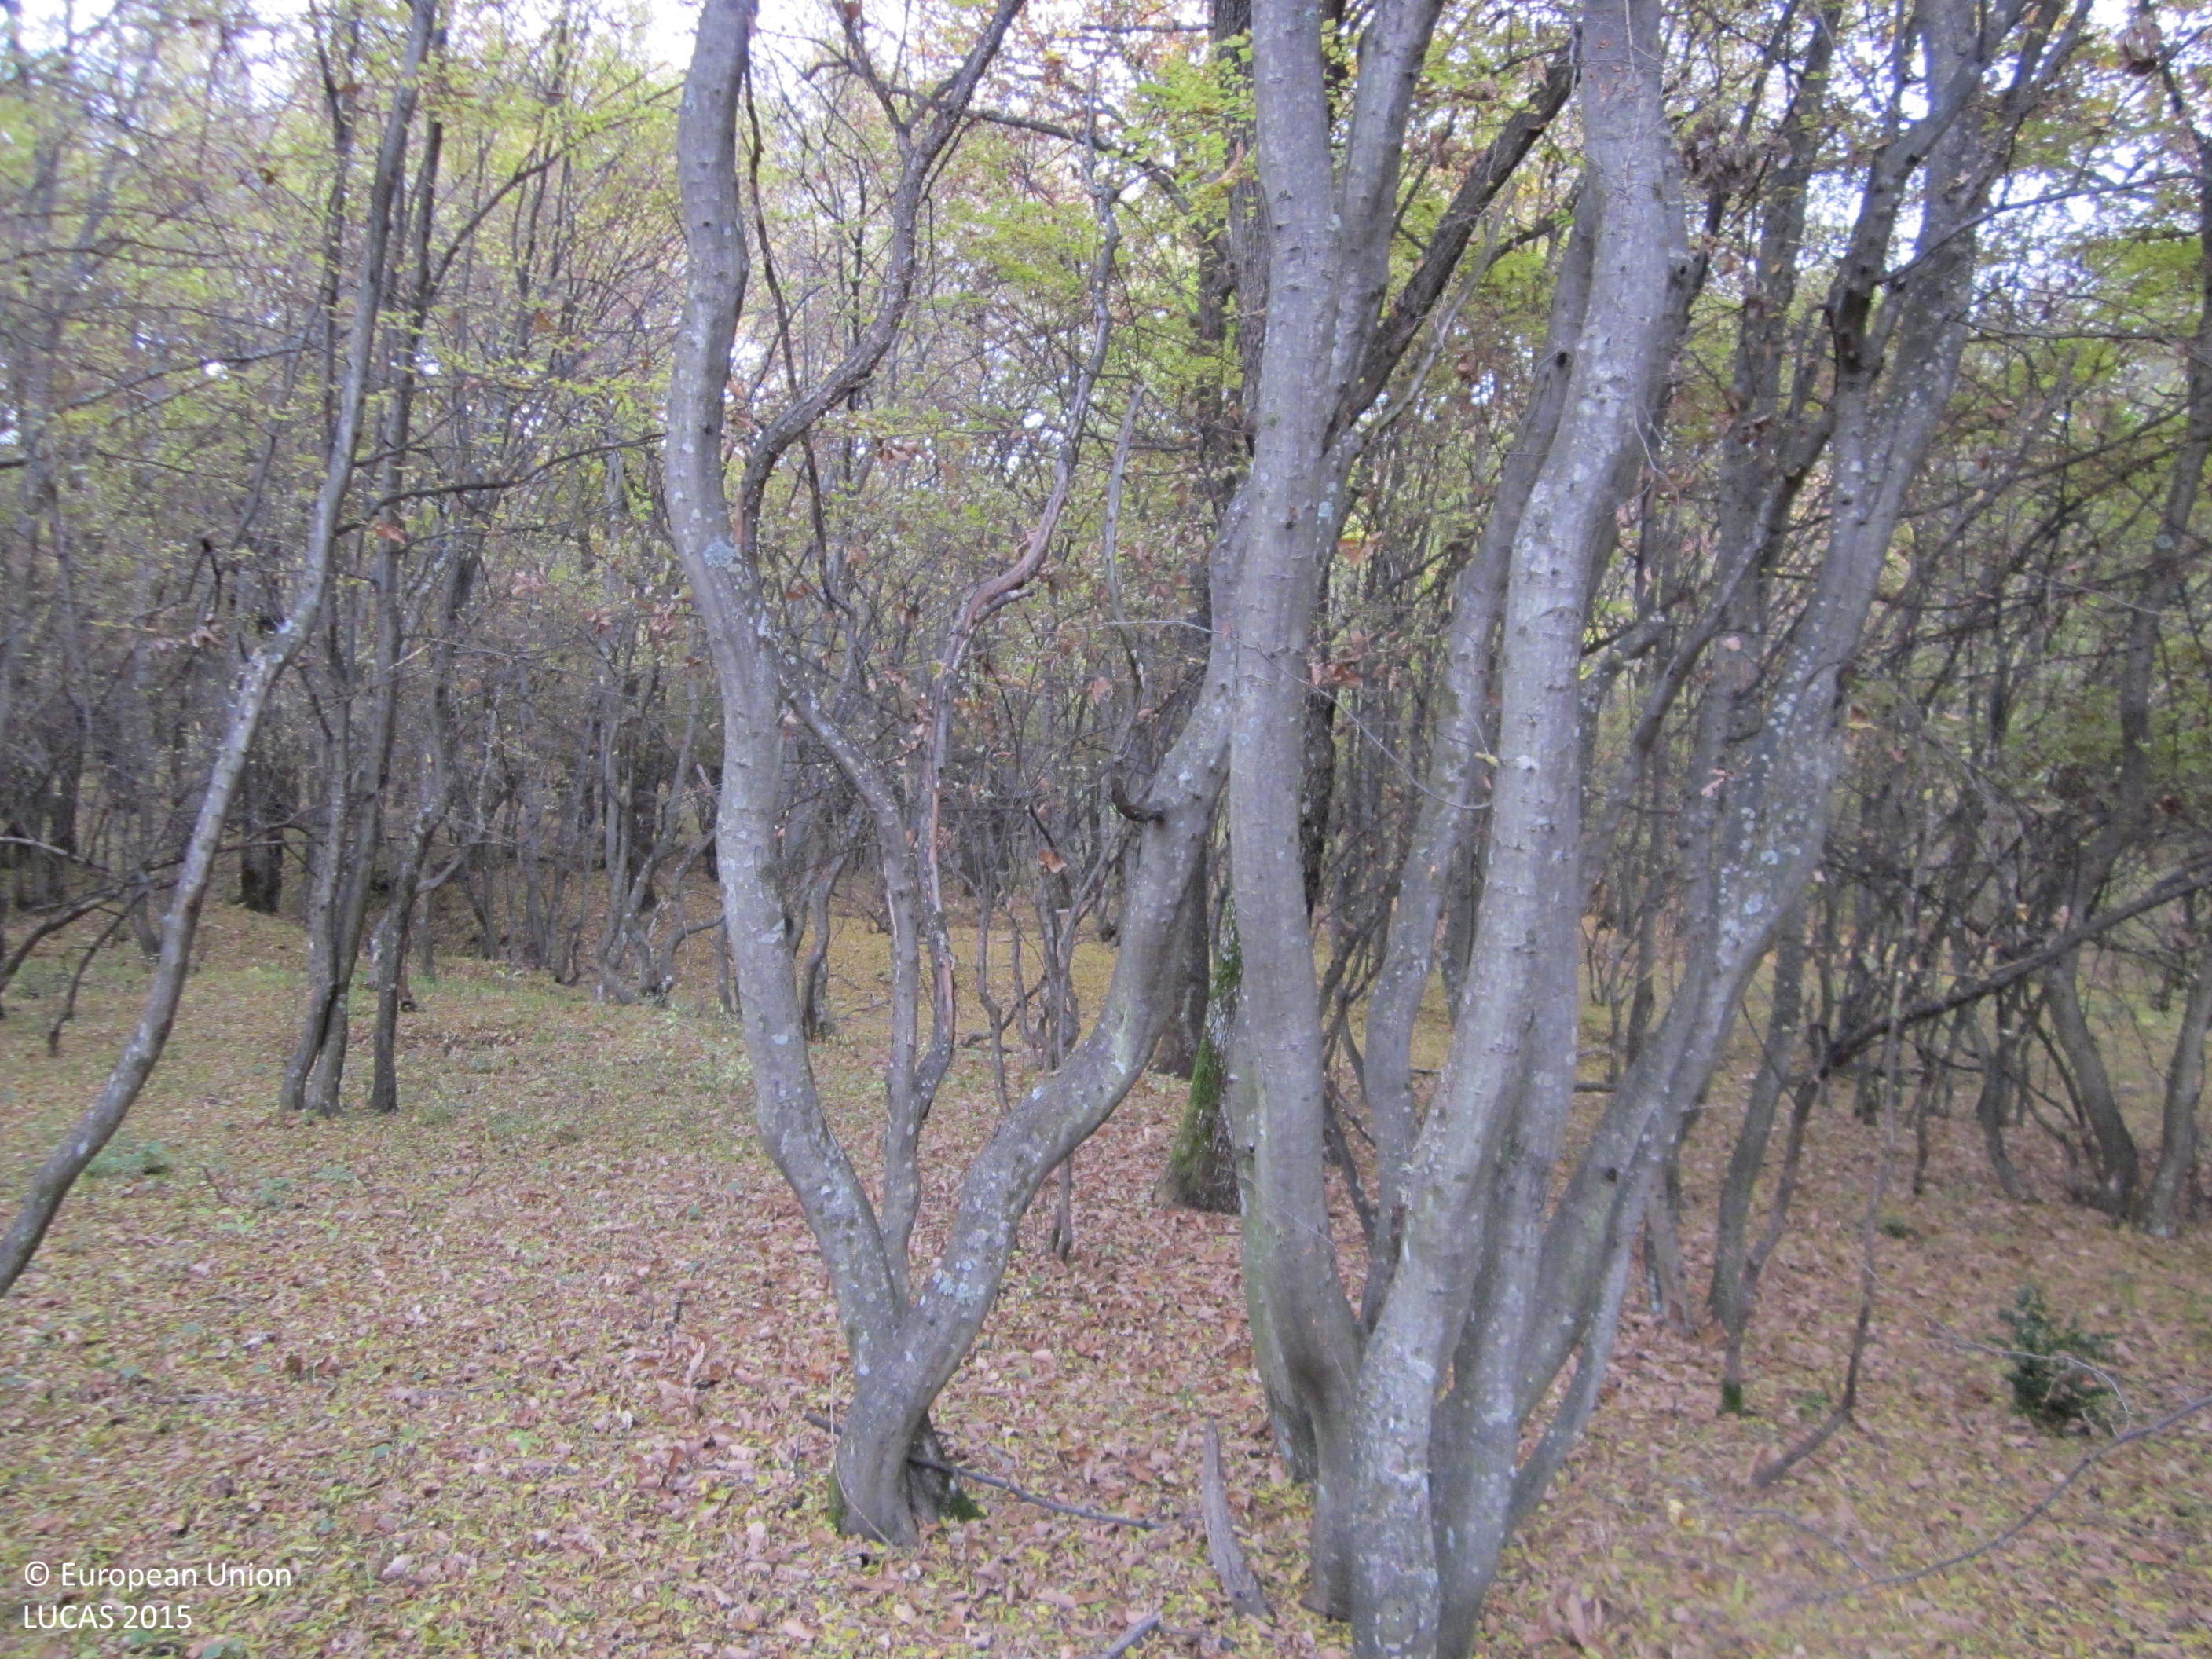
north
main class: Woodland
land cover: Broadleaved woodland
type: mesophytic deciduous forest
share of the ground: > 75 %
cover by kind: broadleaved forest trees 95 %, unconsolidated bare surface 5 %
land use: Forestry
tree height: > 5 m
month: November
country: BG
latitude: 42.4817
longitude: 24.7630
